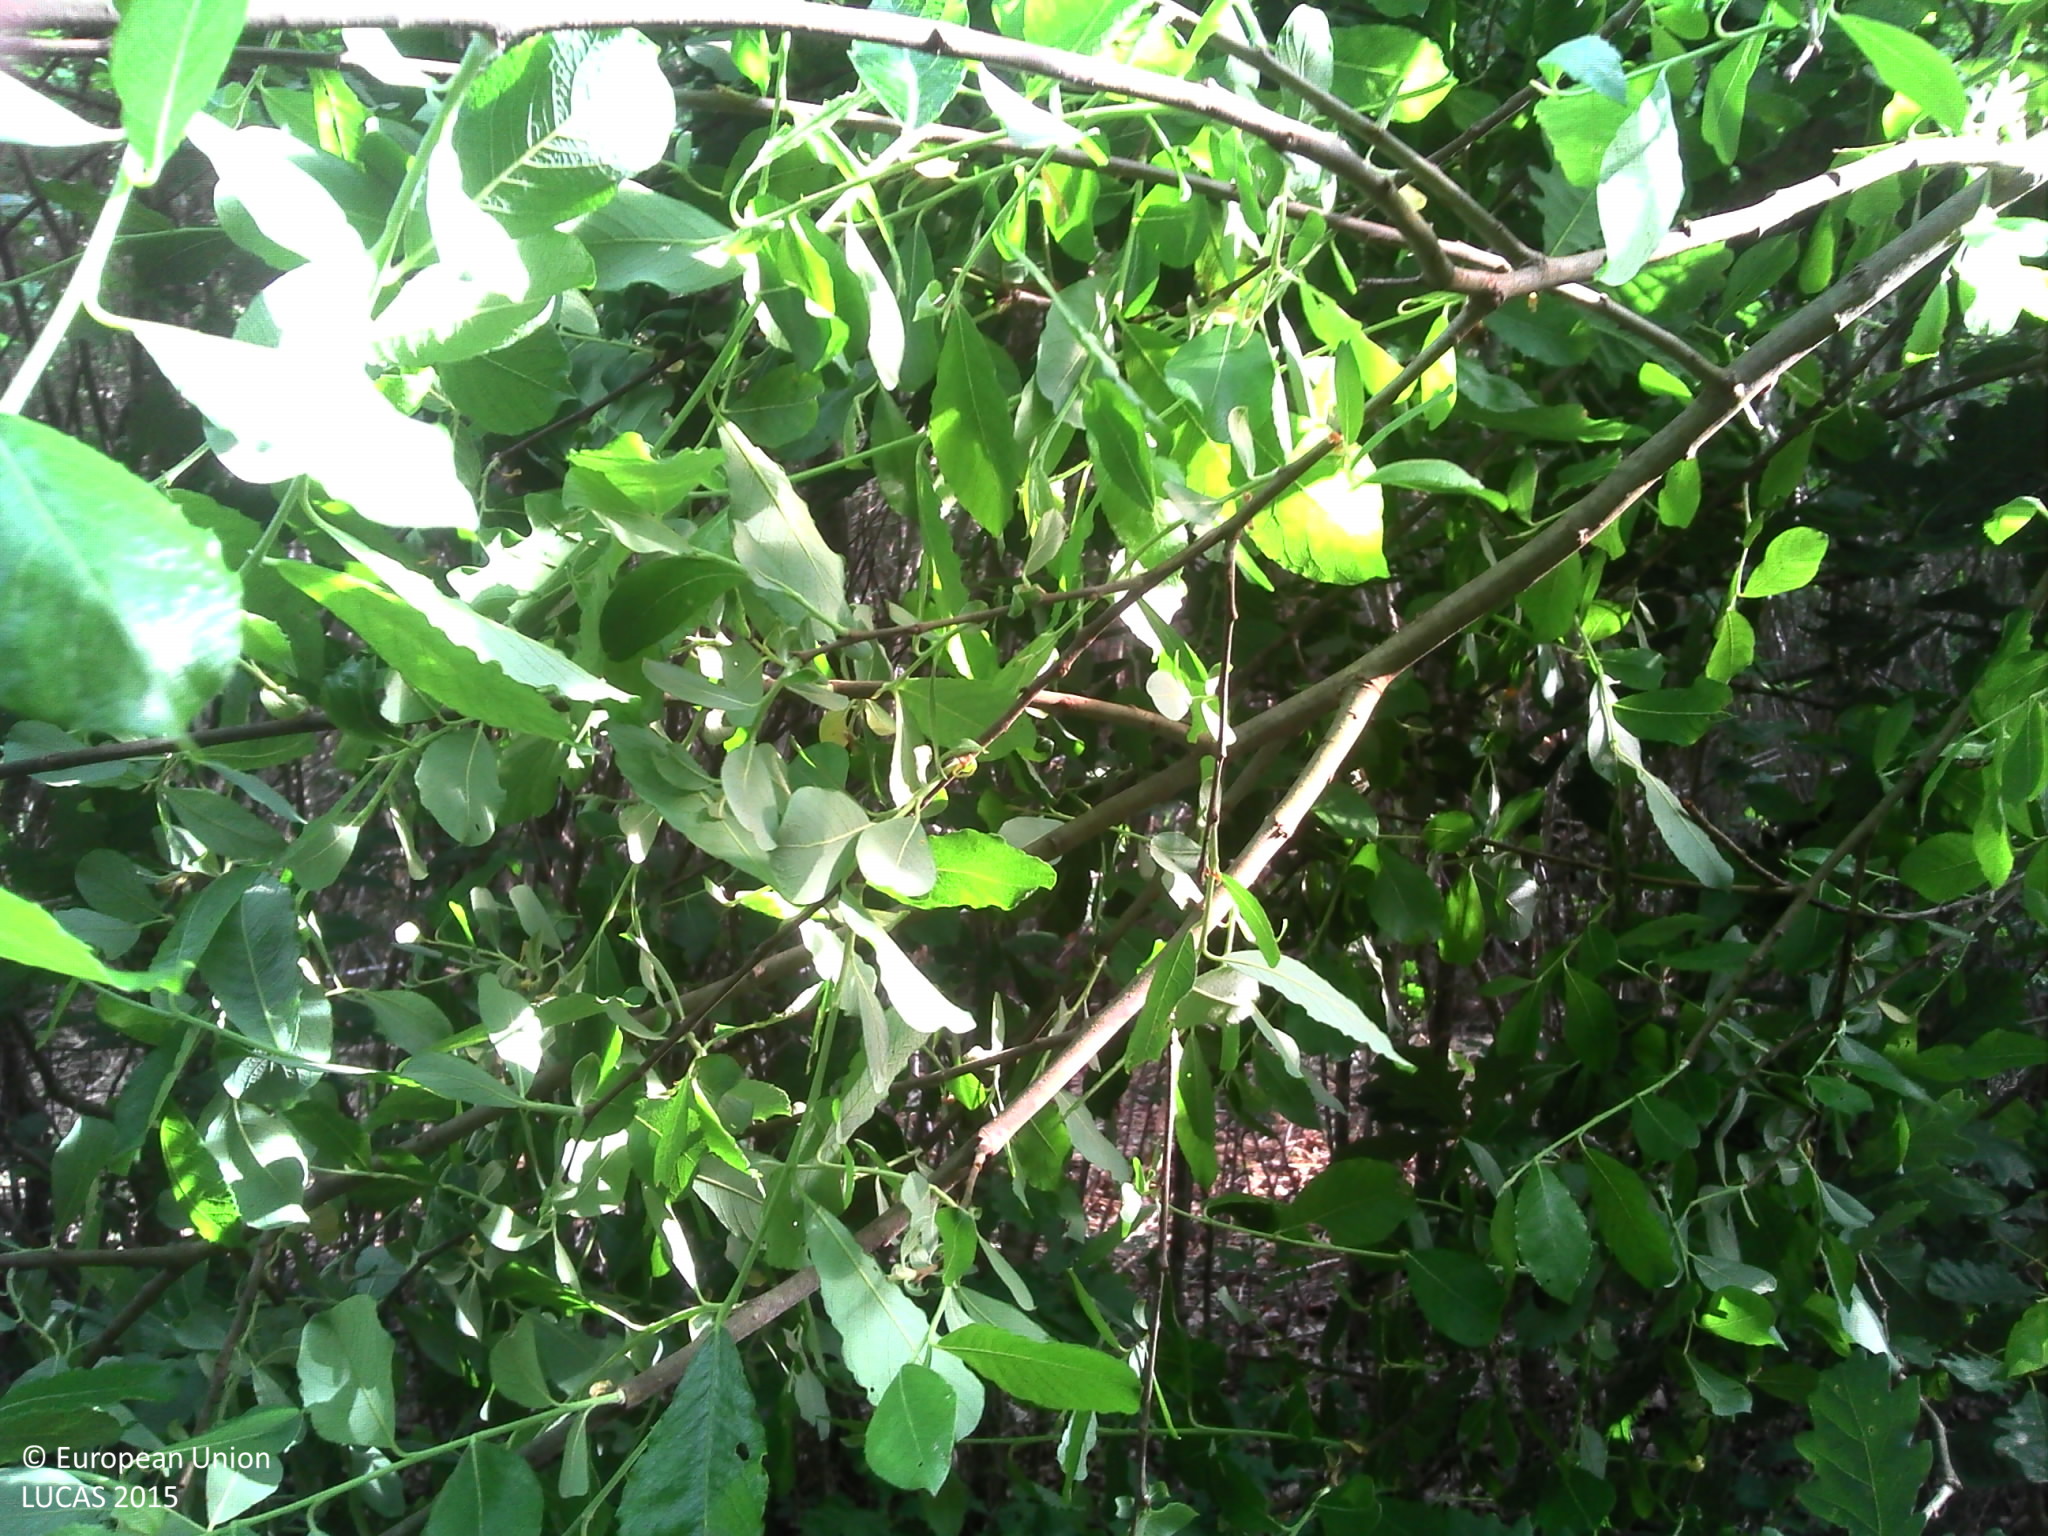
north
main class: Woodland
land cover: Broadleaved woodland
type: mesophytic deciduous forest
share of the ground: > 75 %
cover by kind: broadleaved forest trees 95 %, herbaceous plants 5 %
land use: Forestry
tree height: < 5 m
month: June
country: FR
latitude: 47.5602
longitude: 1.3863
